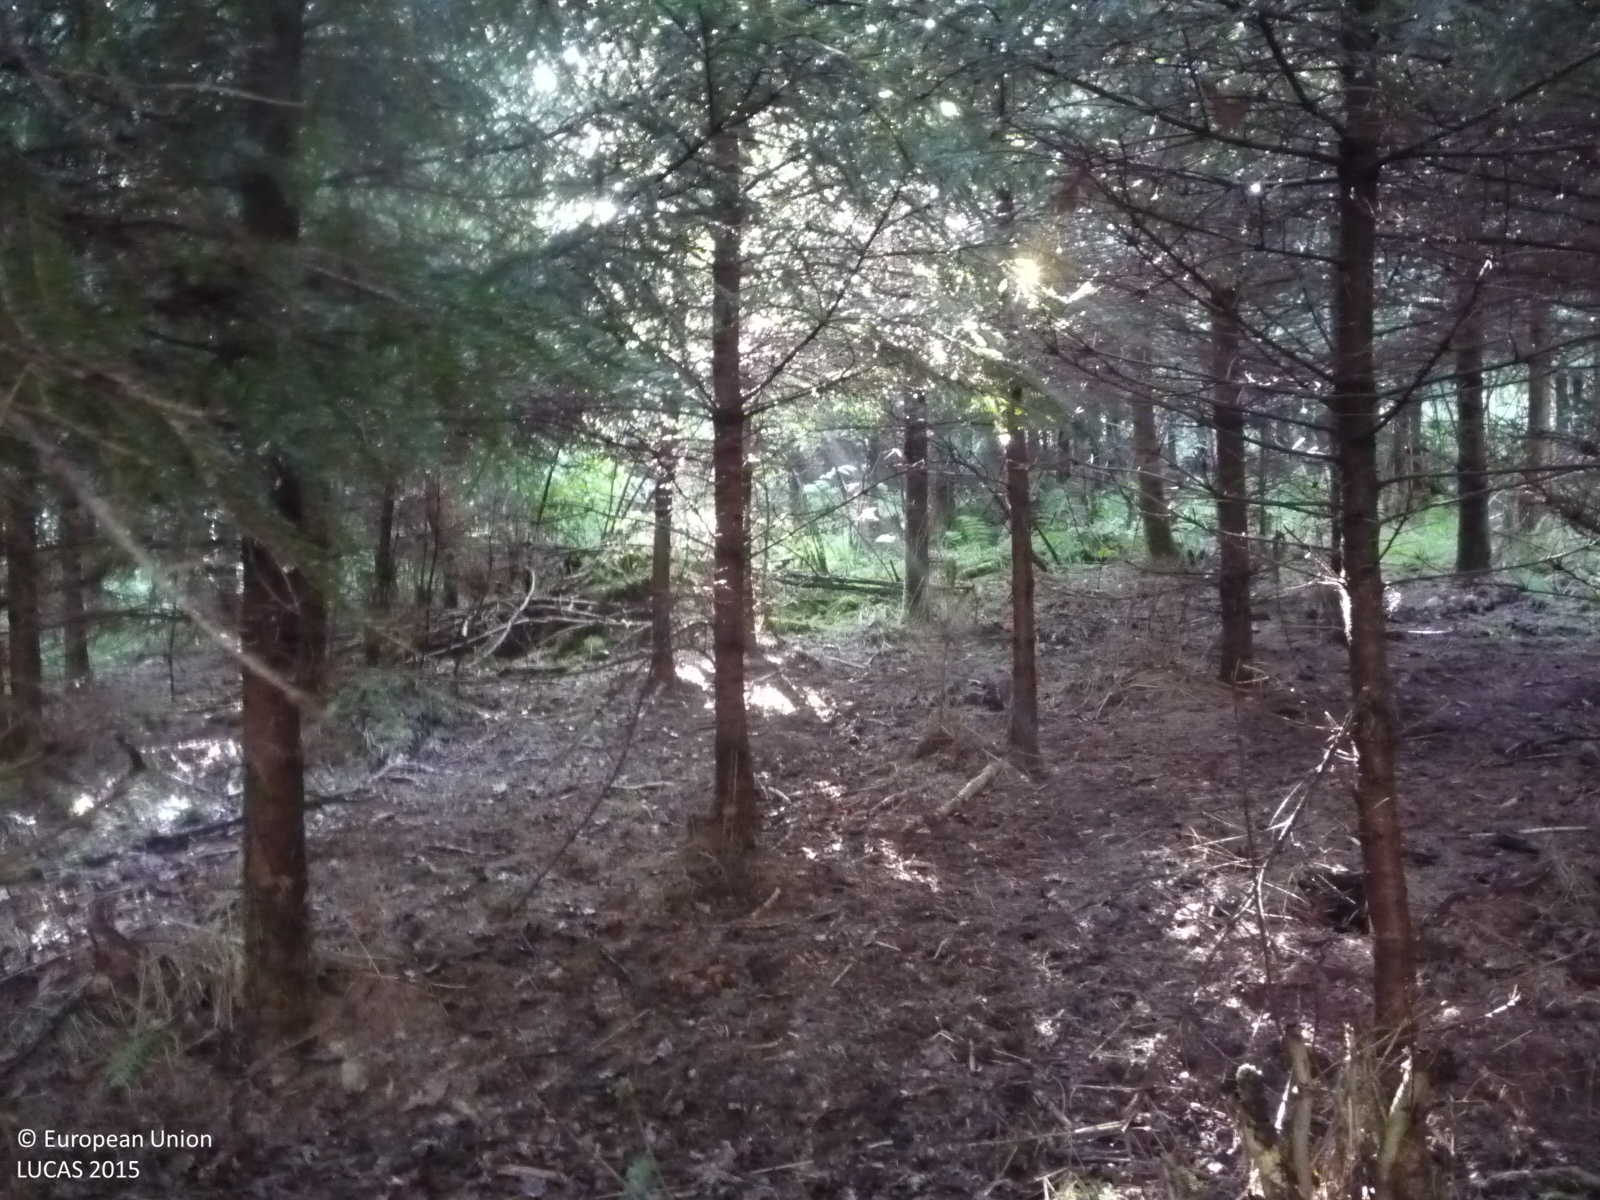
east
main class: Woodland
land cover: Spruce dominated coniferous woodland
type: hemiboreal forest and nemoral coniferous forest and mixed broadleaved-coniferous forest
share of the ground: > 75 %
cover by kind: coniferous forest trees 85 %, herbaceous plants 15 %
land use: Forestry
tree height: > 5 m
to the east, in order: Spruce dominated coniferous woodland; Fences; Spruce dominated mixed woodland; Fences; Spruce dominated coniferous woodland
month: July
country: CZ
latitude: 50.5298
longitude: 15.2938
